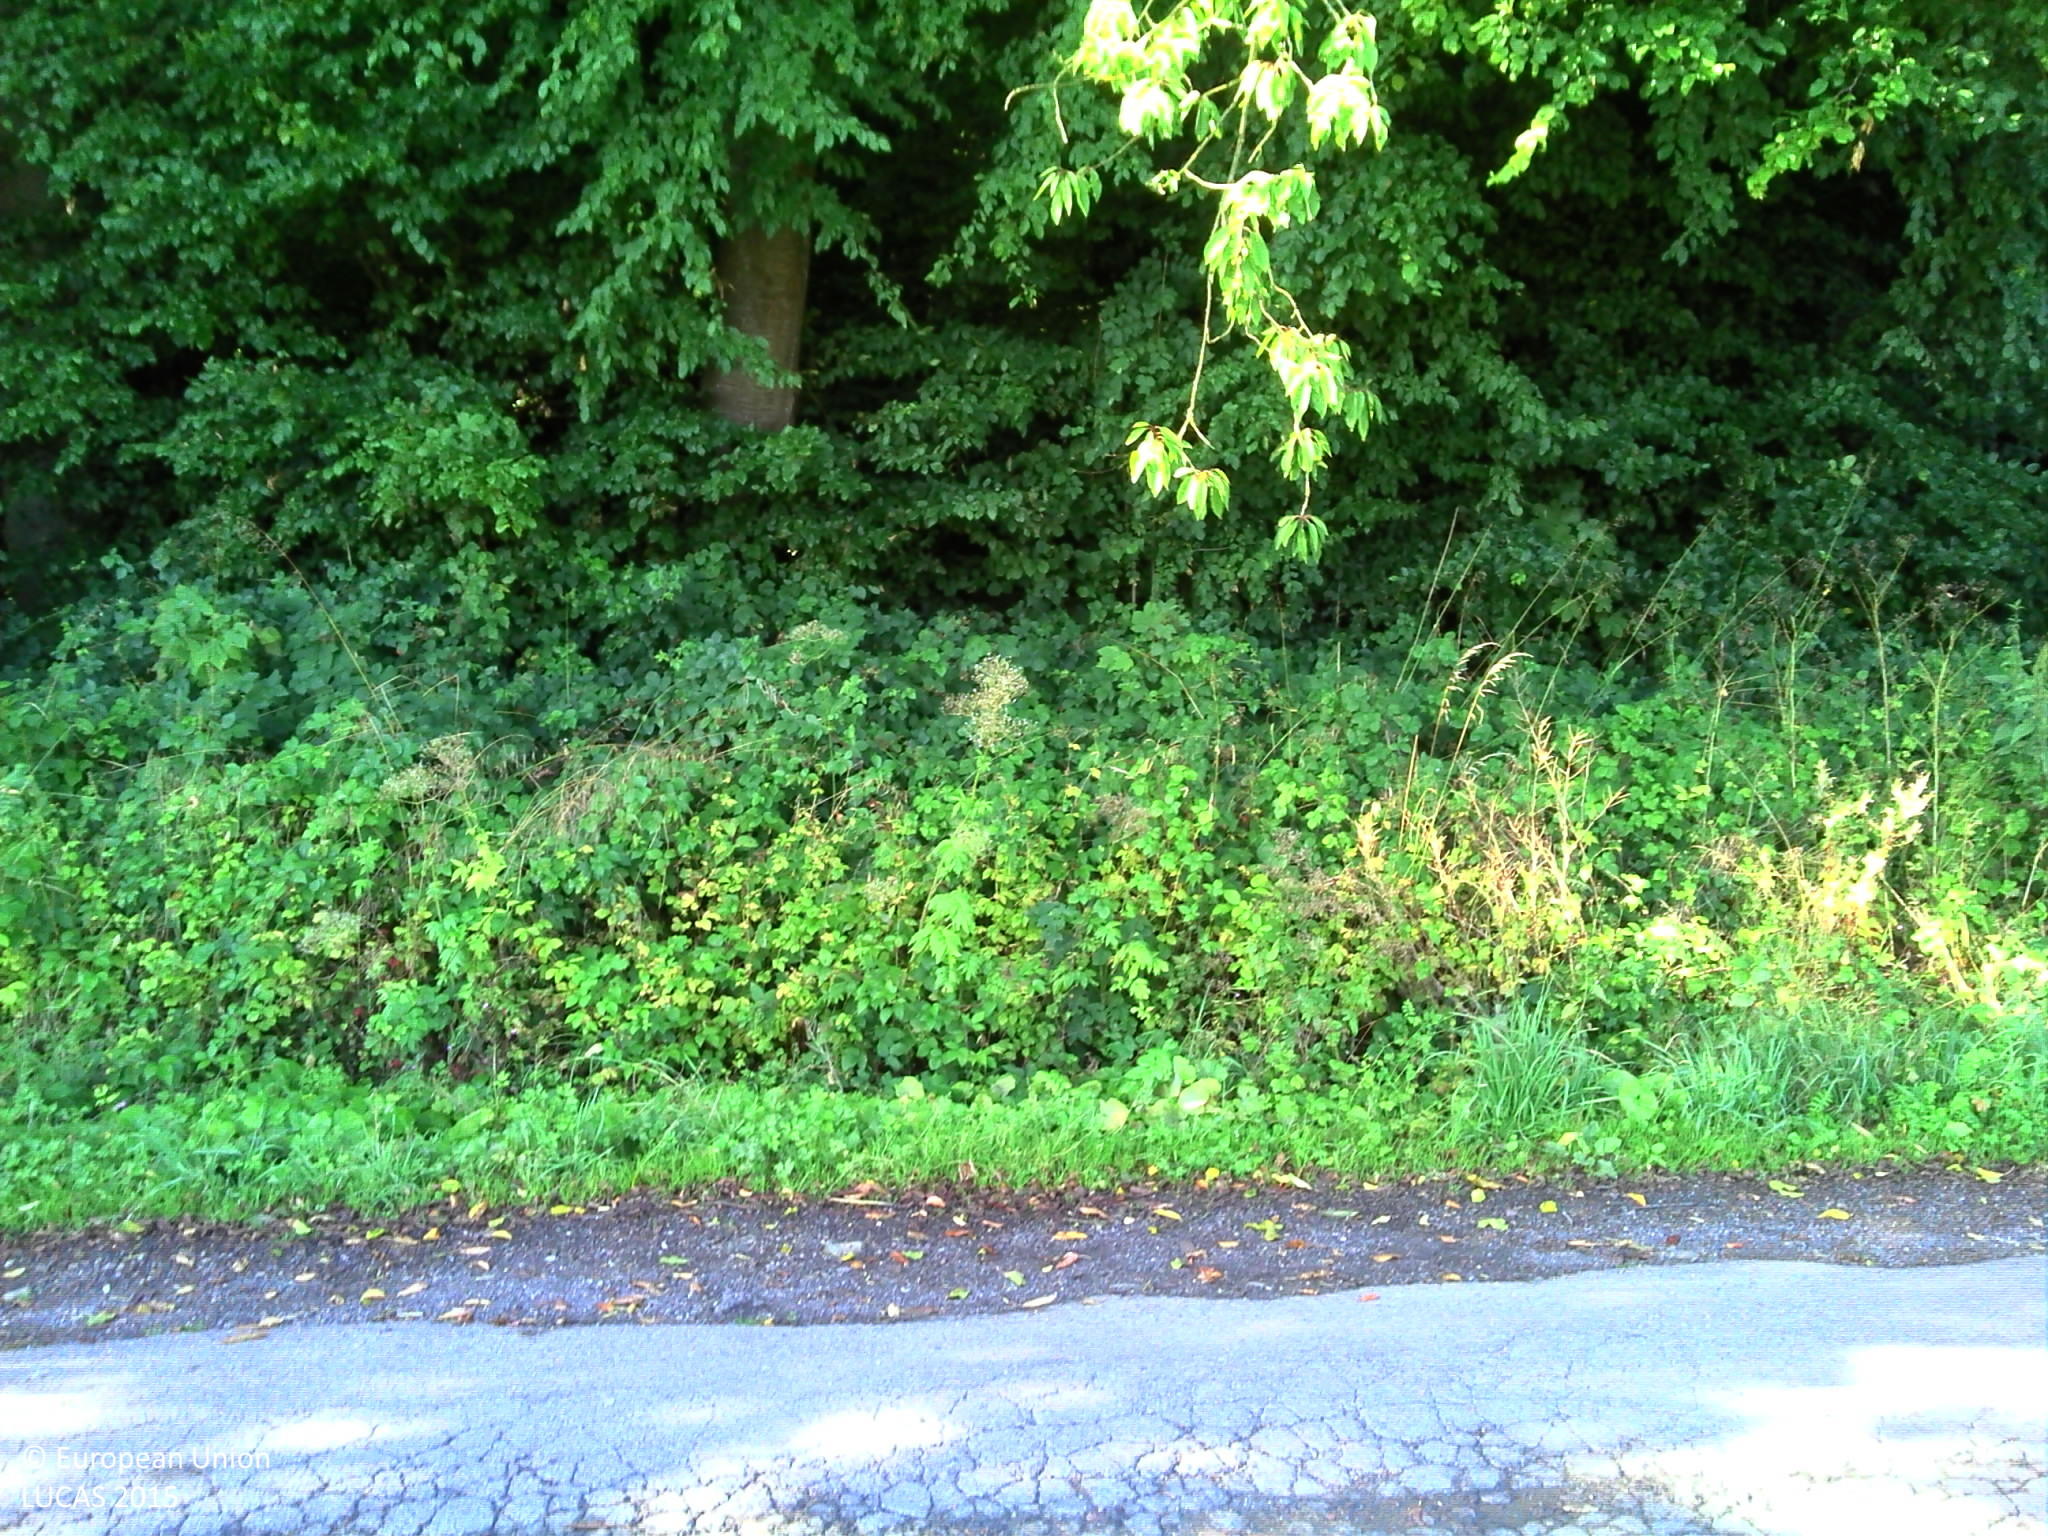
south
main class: Grassland
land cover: Grassland without tree/shrub cover
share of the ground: > 75 %
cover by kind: herbaceous plants 100 %
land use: Agriculture (excluding fallow land and kitchen gardens)
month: August
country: BE
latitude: 50.4171
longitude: 4.6060
